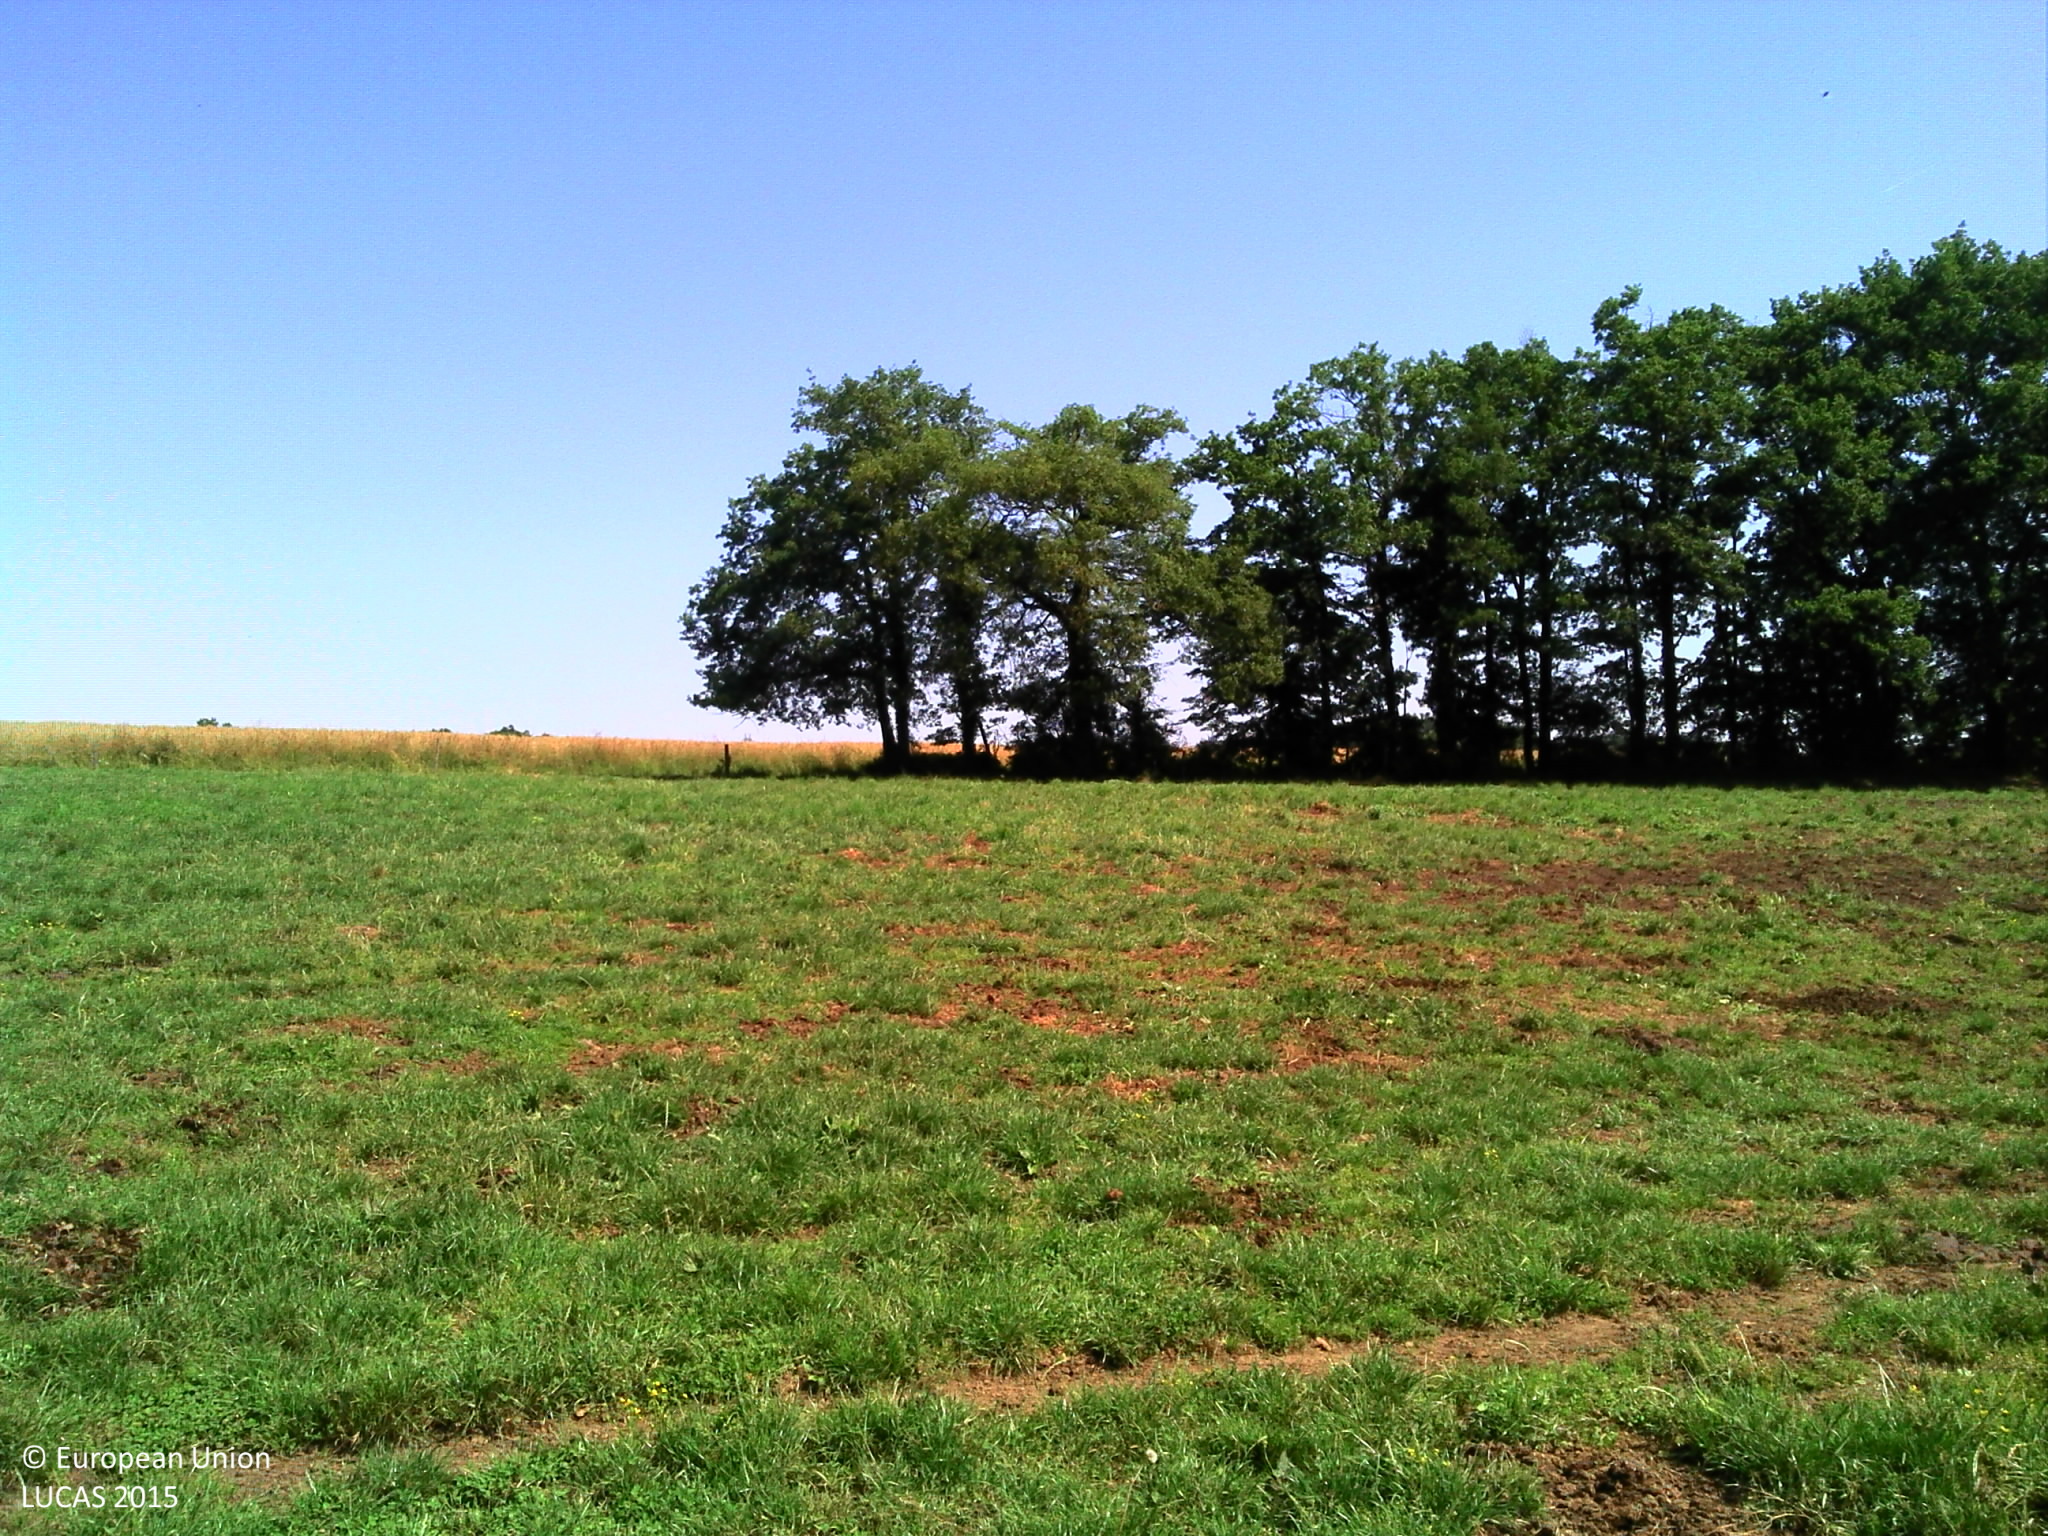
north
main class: Grassland
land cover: Grassland without tree/shrub cover
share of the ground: > 75 %
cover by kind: herbaceous plants 100 %
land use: Agriculture (excluding fallow land and kitchen gardens)
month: June
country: FR
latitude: 45.8814
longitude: 0.5928
